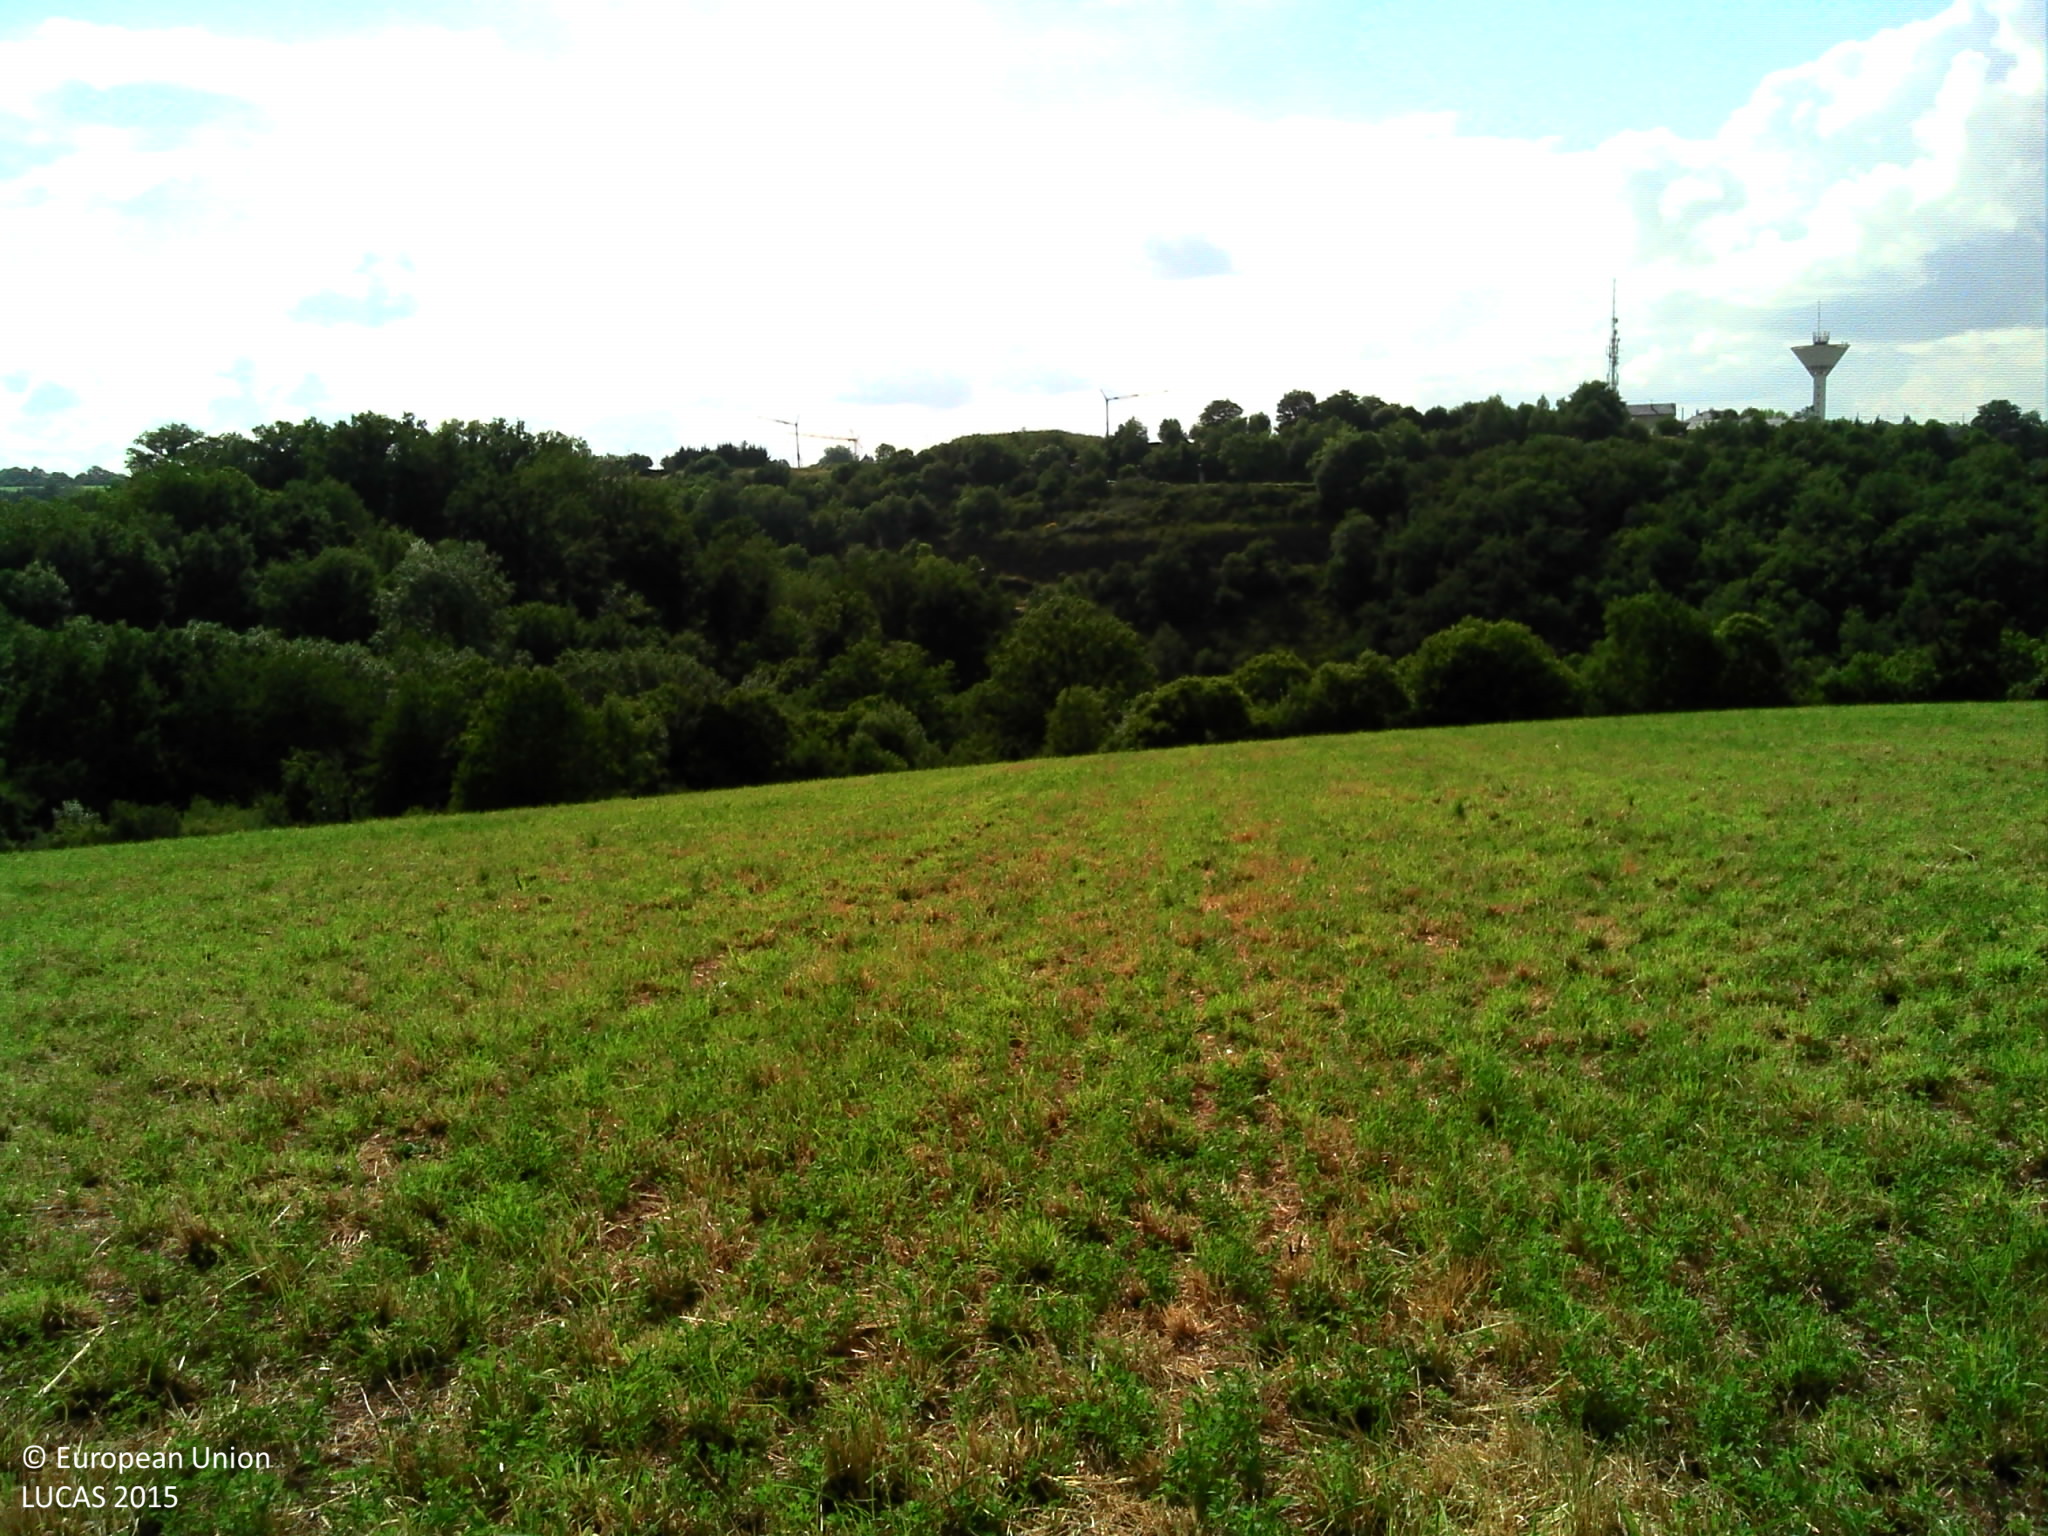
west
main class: Cropland
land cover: Lucerne
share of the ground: 50 - 75 %
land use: Agriculture (excluding fallow land and kitchen gardens)
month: June
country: FR
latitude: 44.3372
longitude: 2.5659
